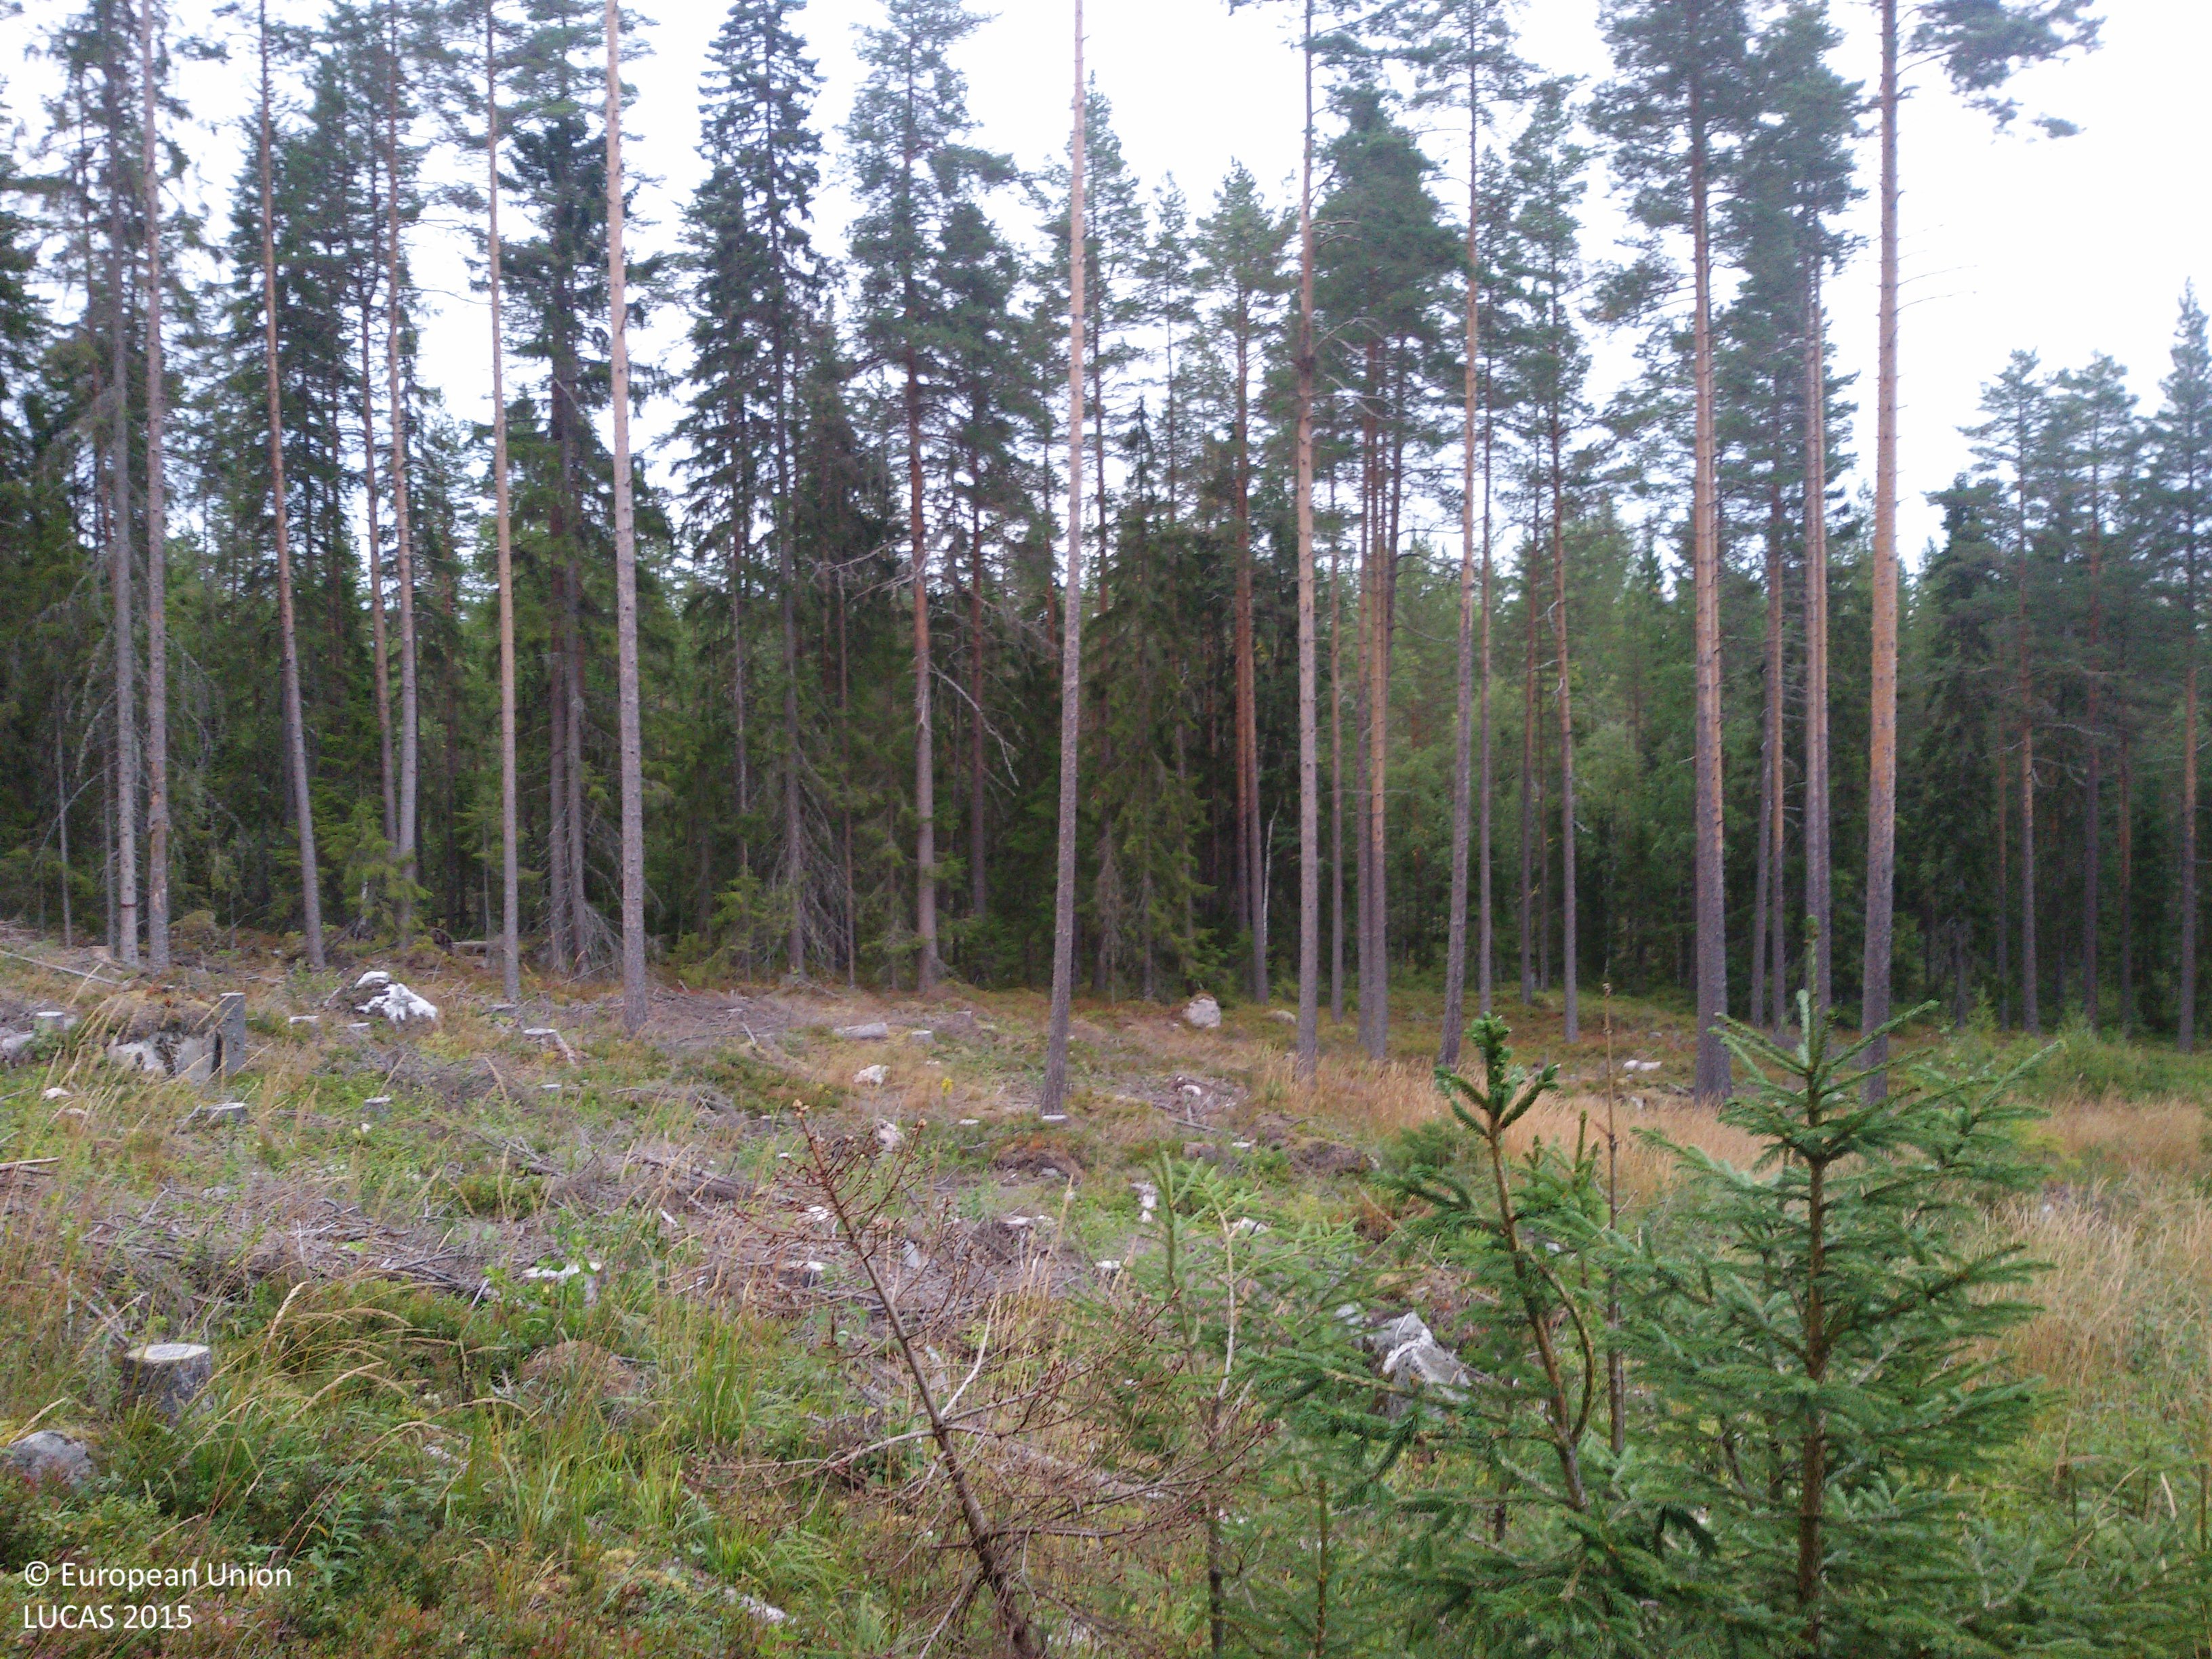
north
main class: Woodland
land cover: Spruce dominated coniferous woodland
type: boreal forest
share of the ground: 10 - 25 %
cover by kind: herbaceous plants 70 %, coniferous forest trees 20 %
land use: Forestry
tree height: > 5 m
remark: Nursery
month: September
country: SE
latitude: 60.9327
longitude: 15.6877
